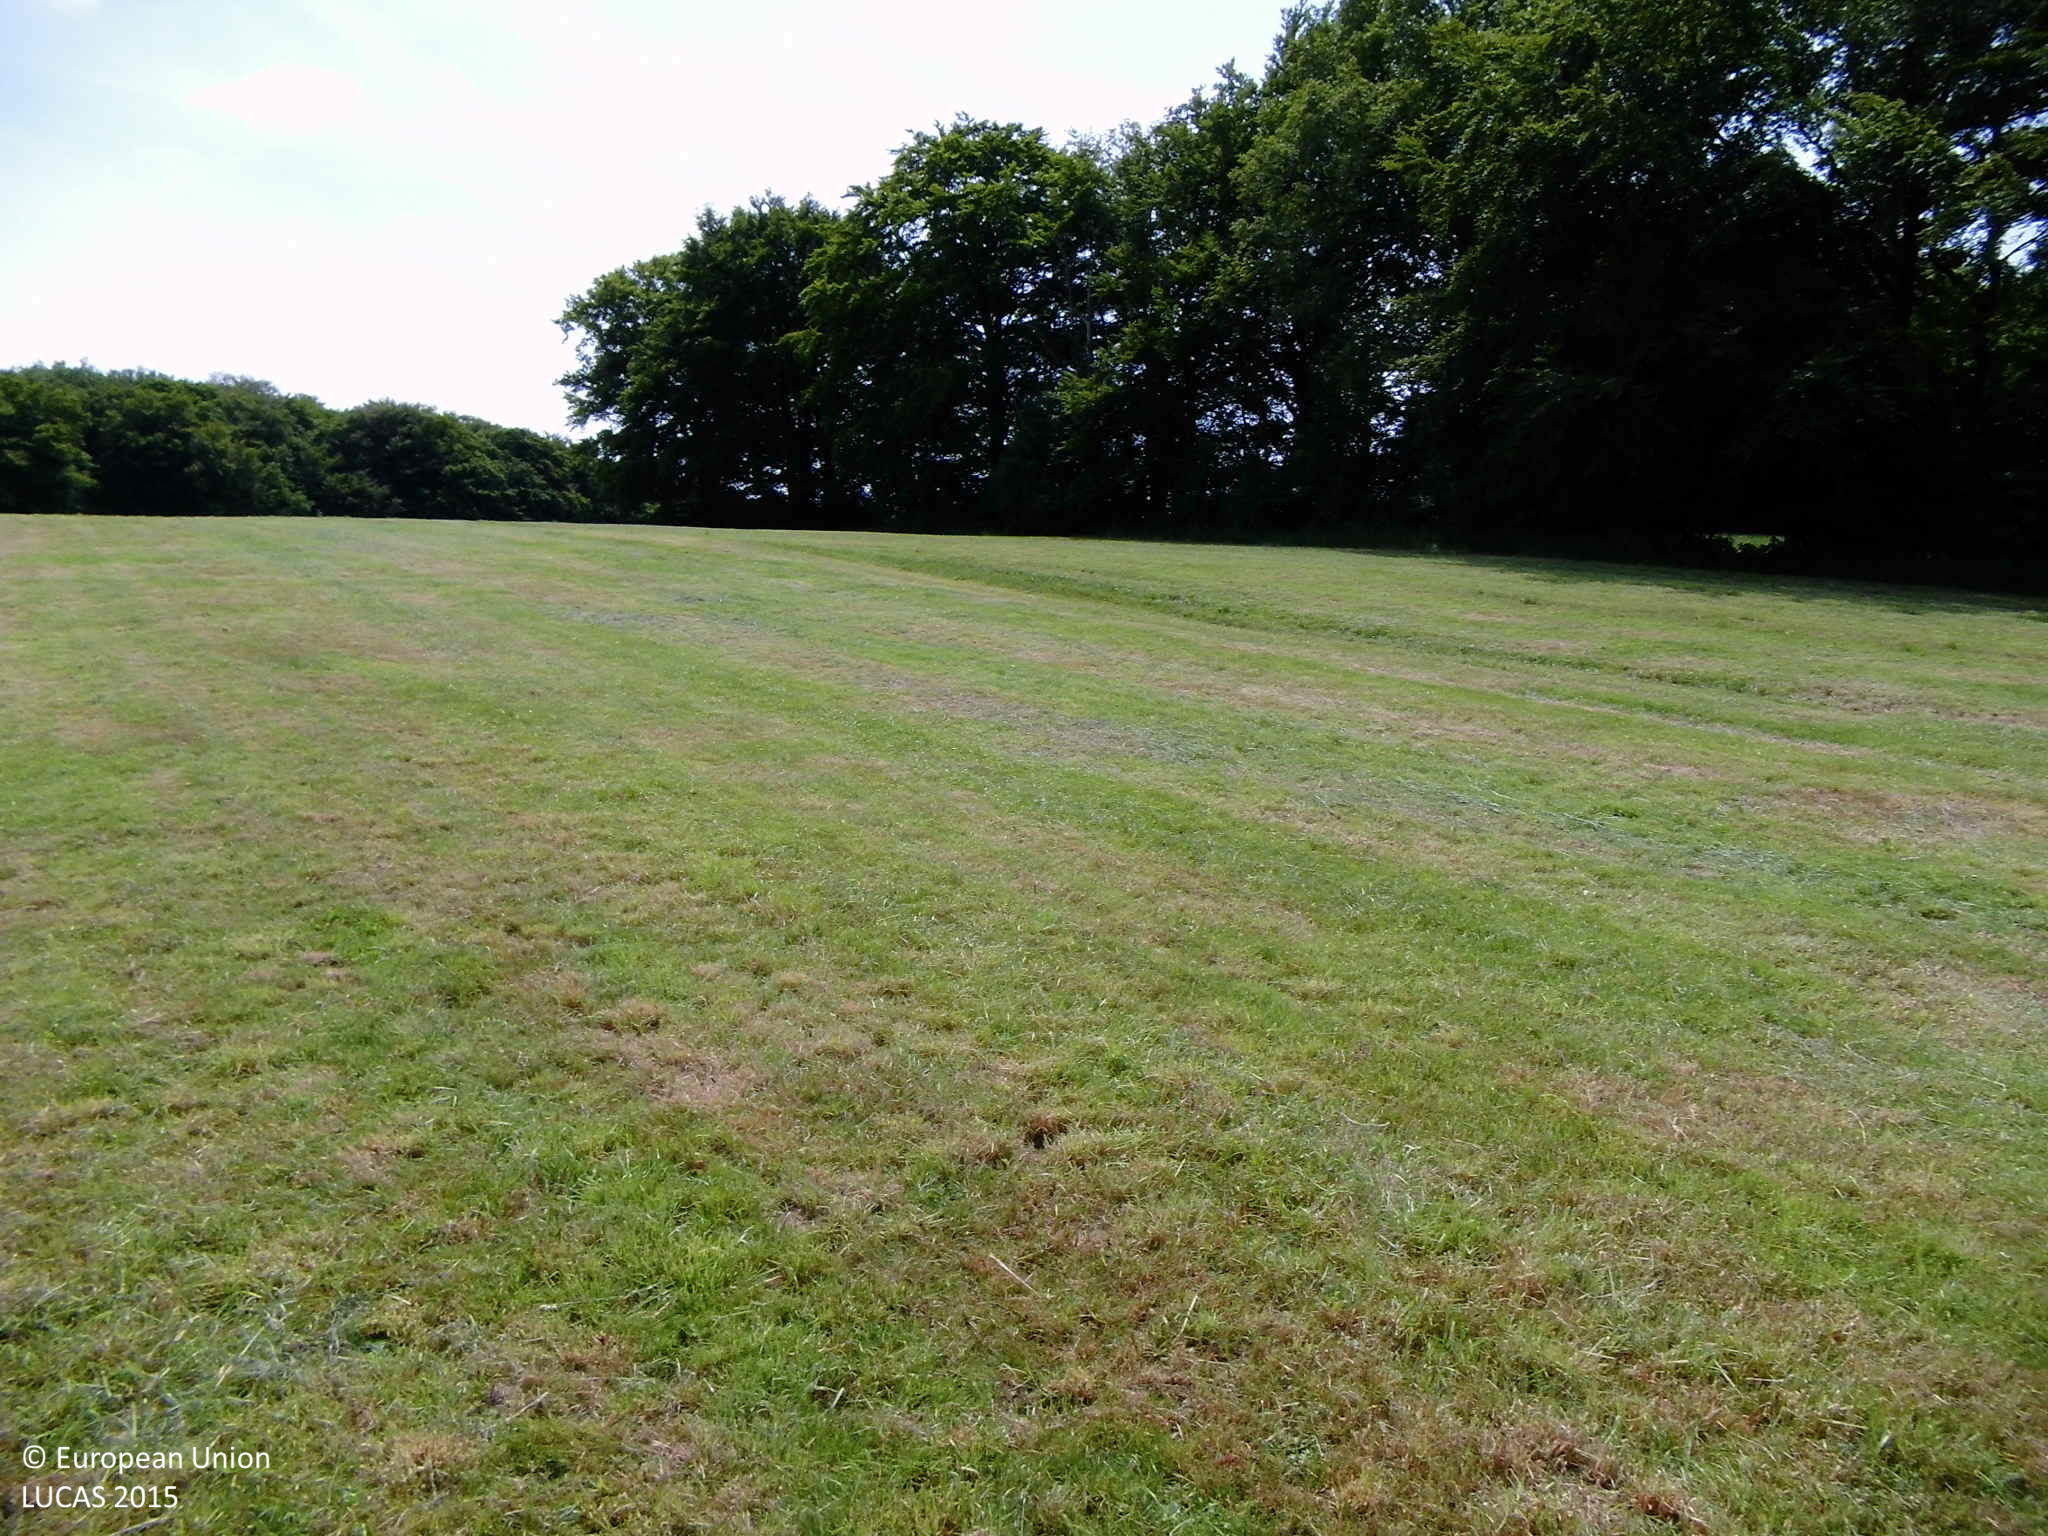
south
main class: Grassland
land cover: Grassland without tree/shrub cover
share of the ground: > 75 %
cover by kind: herbaceous plants 100 %
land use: Agriculture (excluding fallow land and kitchen gardens)
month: June
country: DE
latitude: 51.1090
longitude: 7.4435
